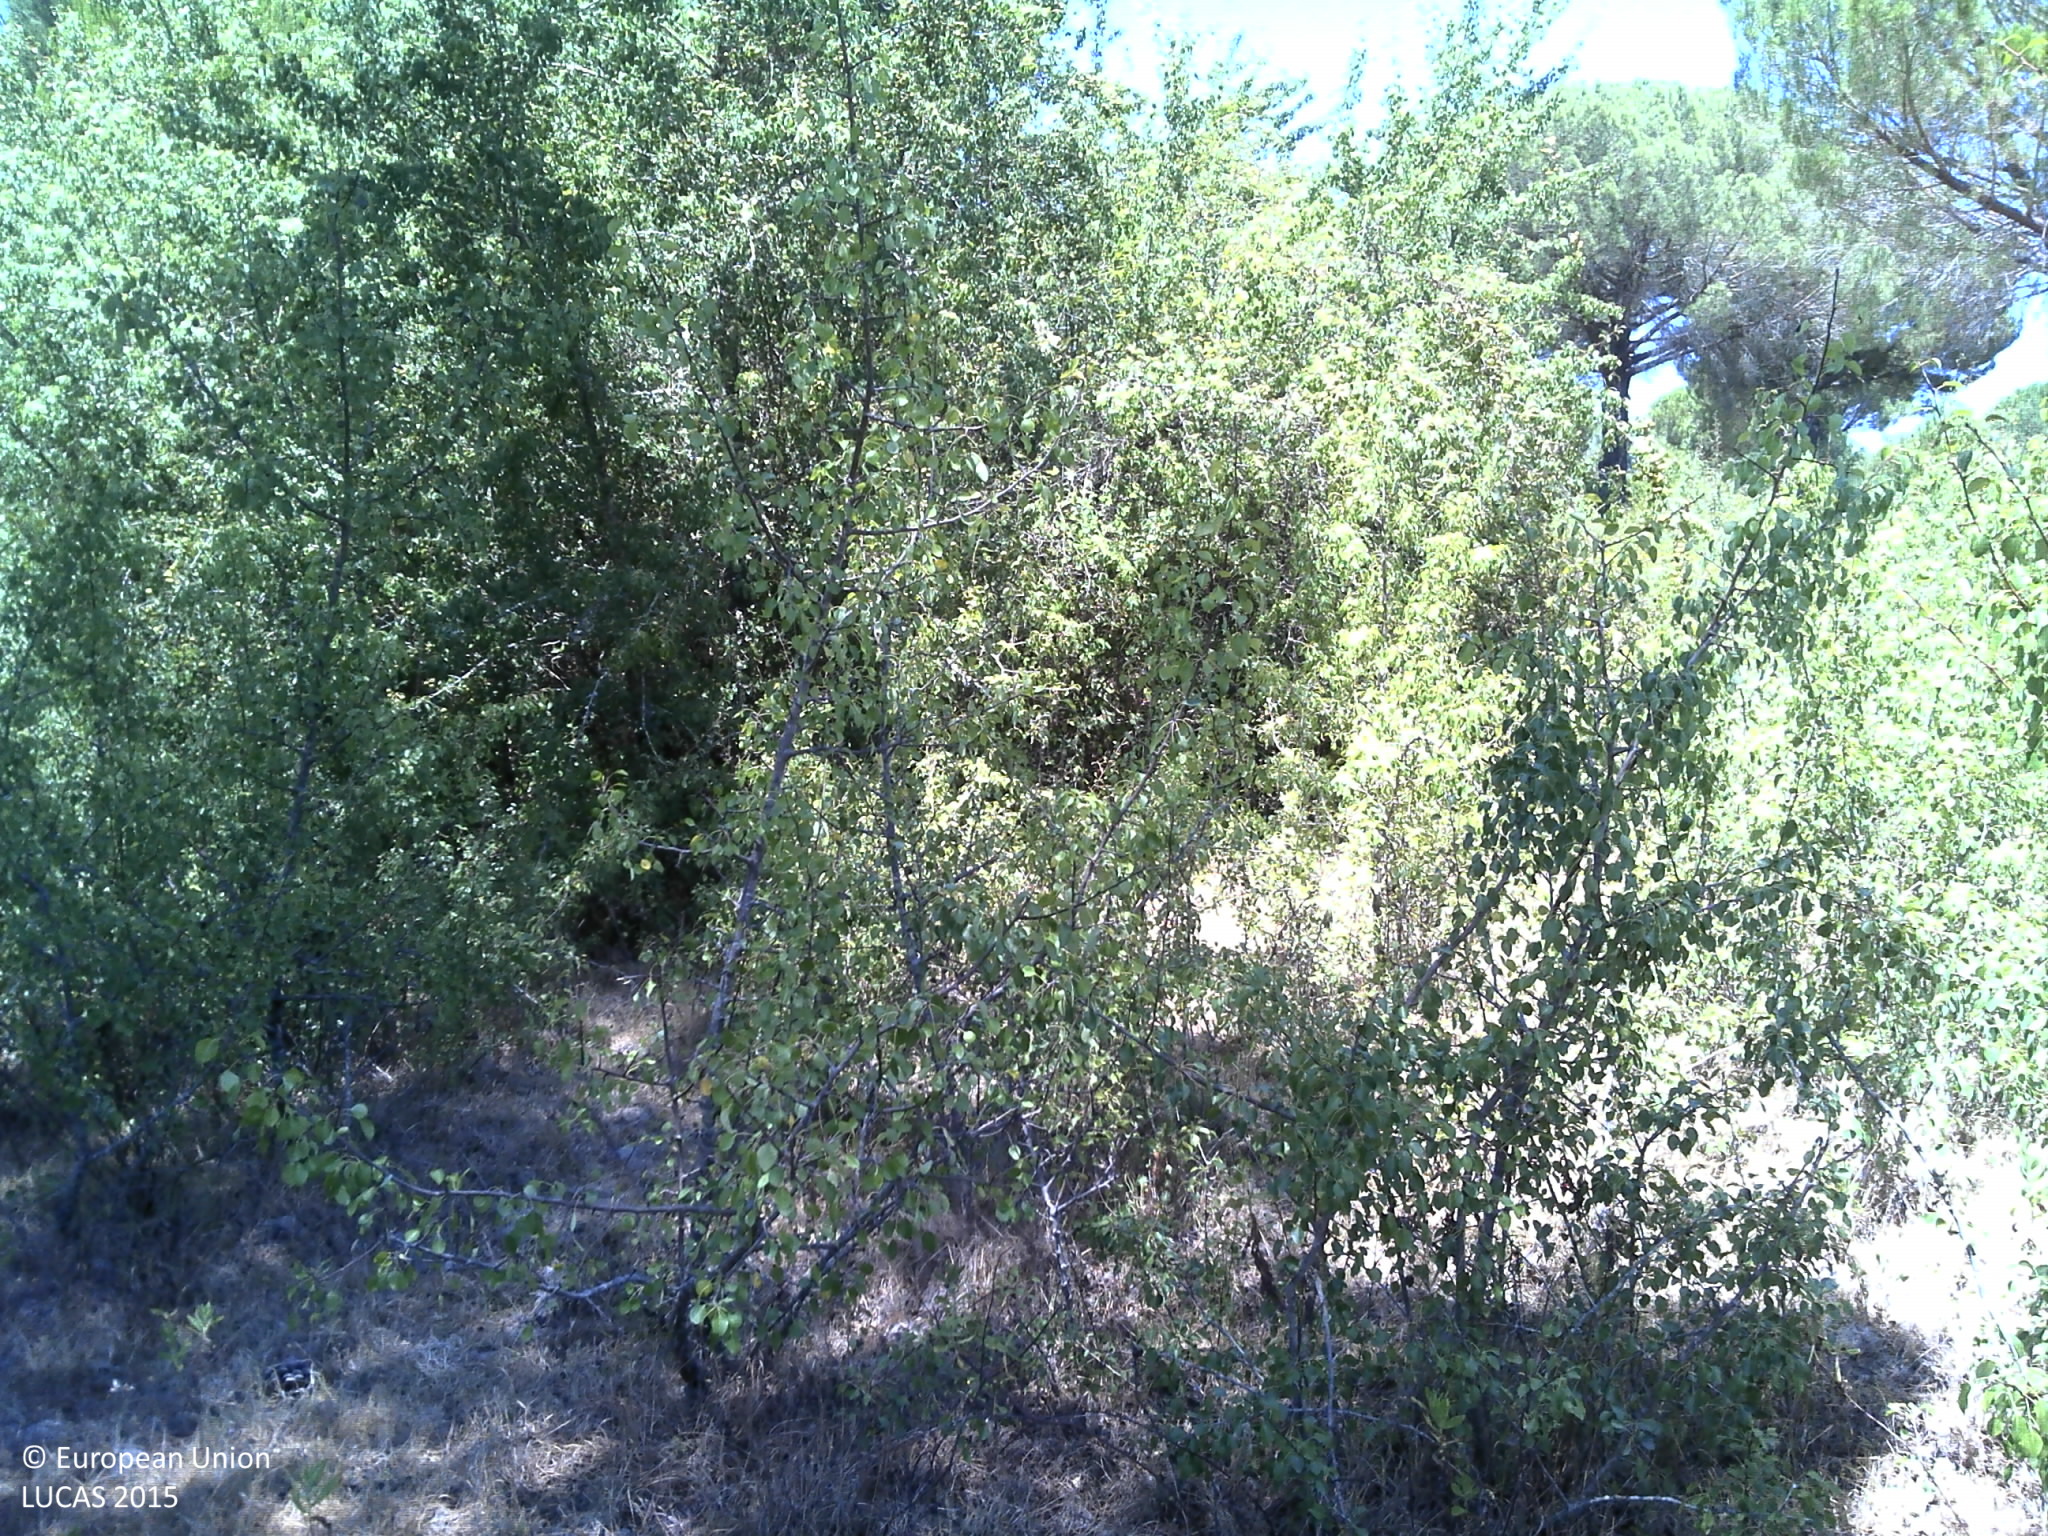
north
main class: Woodland
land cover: Pine dominated mixed woodland
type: coniferous forest of the mediterranean region
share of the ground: 10 - 25 %
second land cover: Shrubland without tree cover
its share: 10 - 25 %
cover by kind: herbaceous plants 30 %, unconsolidated bare surface 30 %, coniferous forest trees 15 %, shrubs 15 %, broadleaved forest trees 10 %
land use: Forestry
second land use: Agriculture (excluding fallow land and kitchen gardens)
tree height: > 5 m
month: July
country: PT
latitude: 38.5738
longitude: -8.5470
